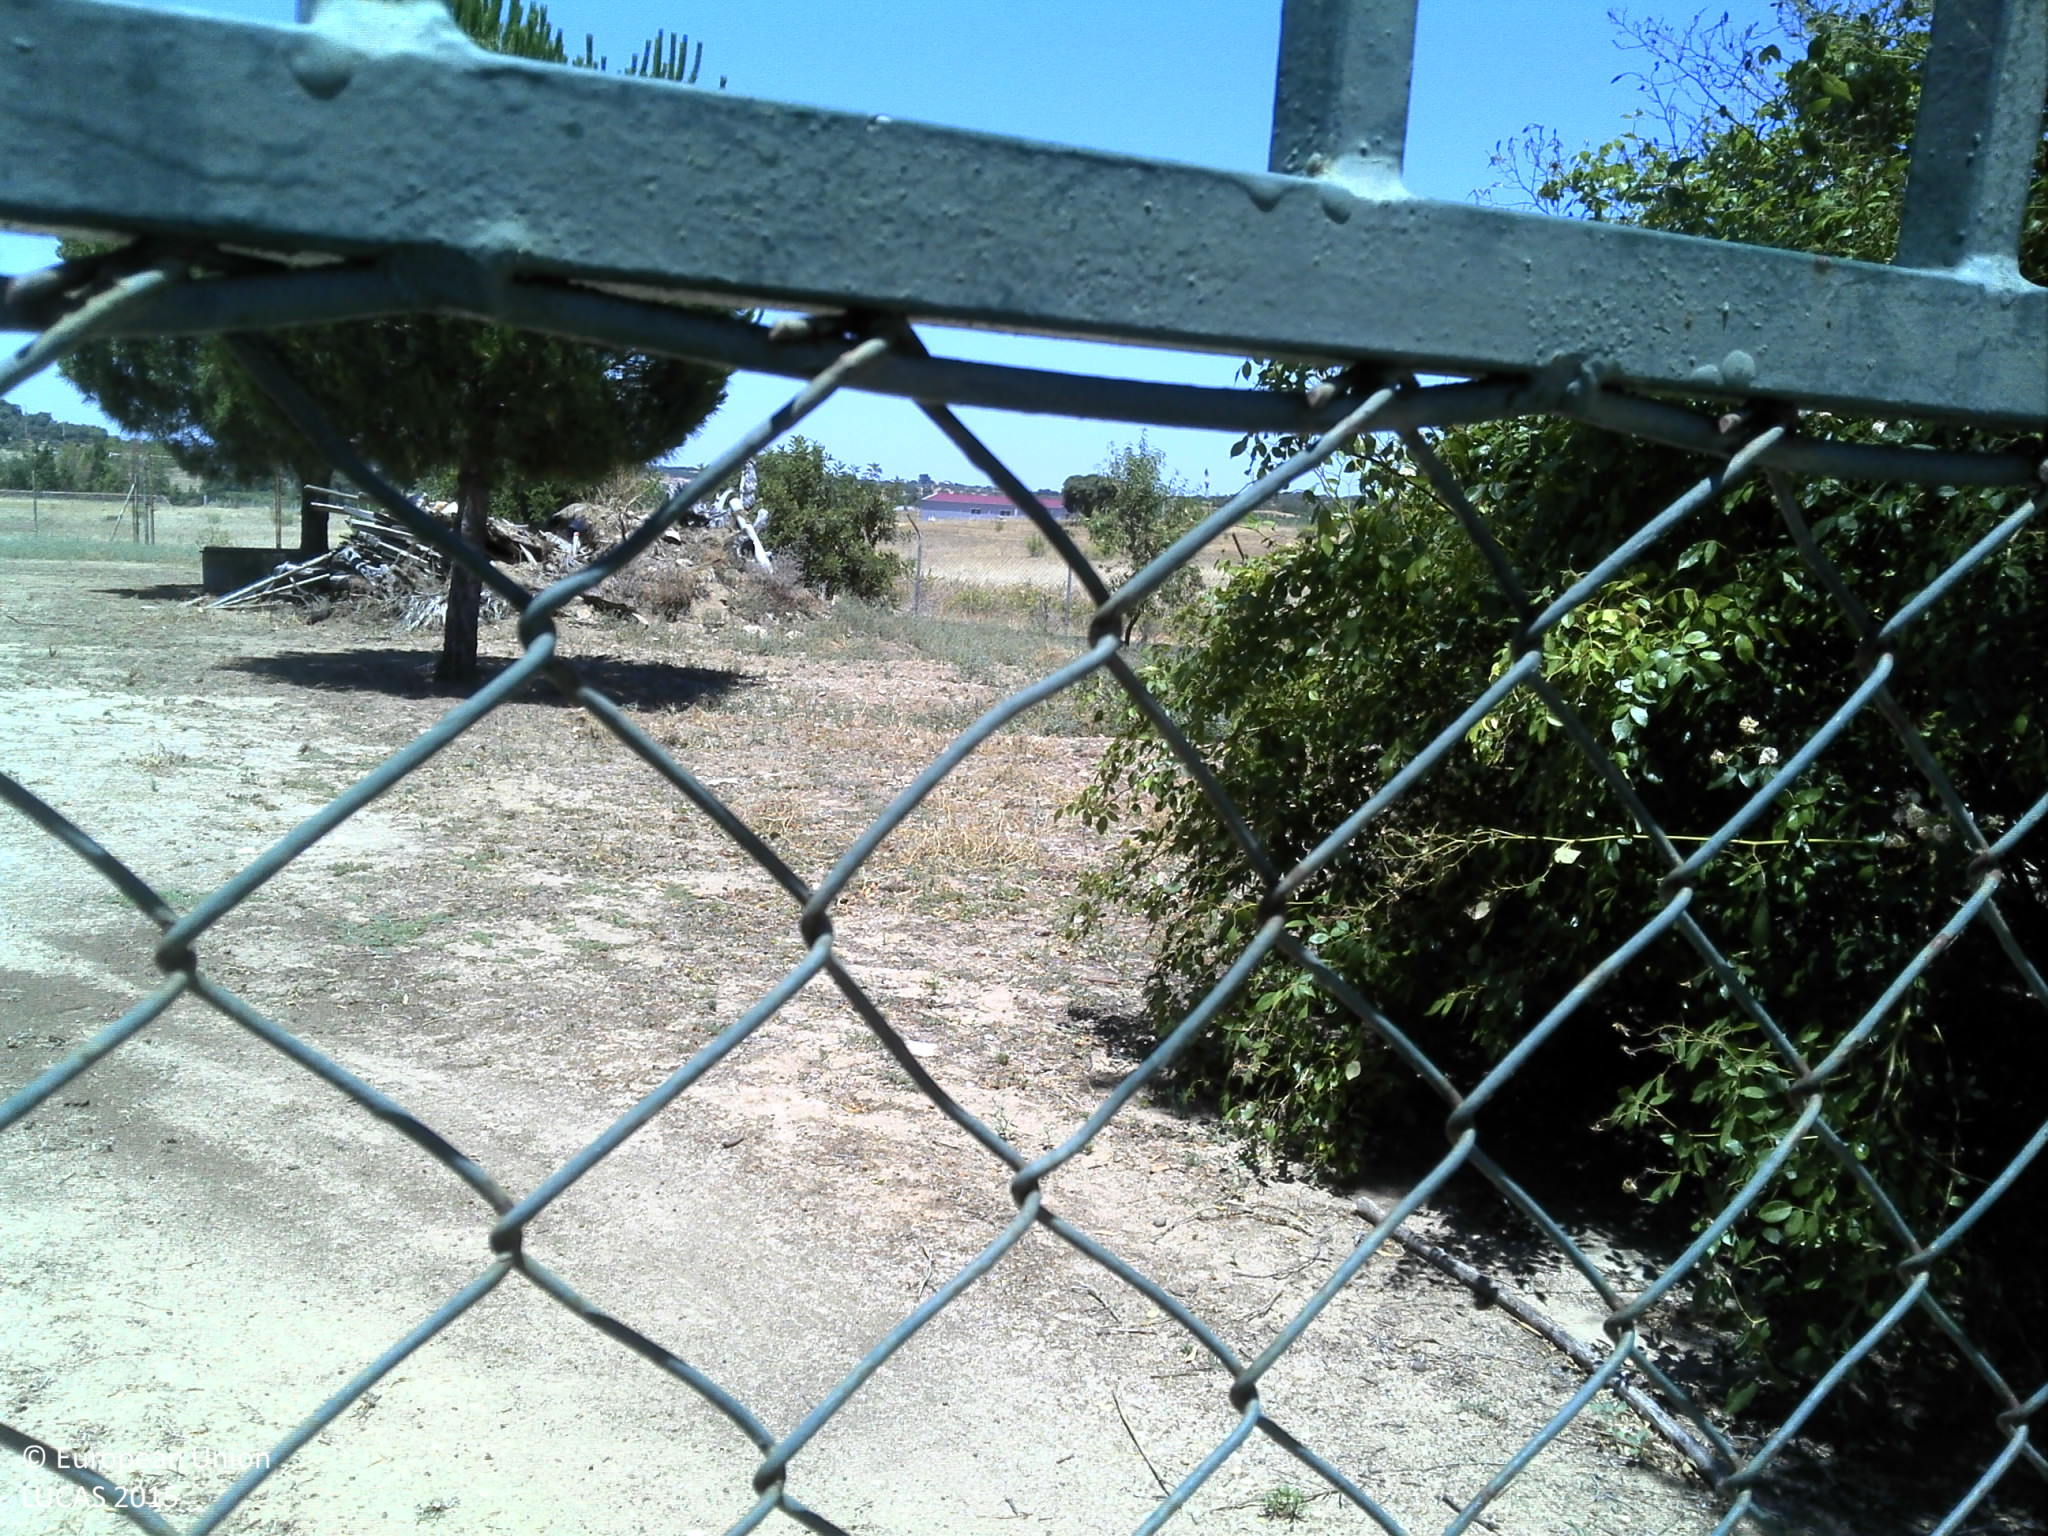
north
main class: Grassland
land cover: Grassland with sparse tree/shrub cover
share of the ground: 25 - 50 %
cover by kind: unconsolidated bare surface 60 %, herbaceous plants 35 %, coniferous forest trees 5 %
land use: Residential
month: June
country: PT
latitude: 37.9279
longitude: -7.5738
